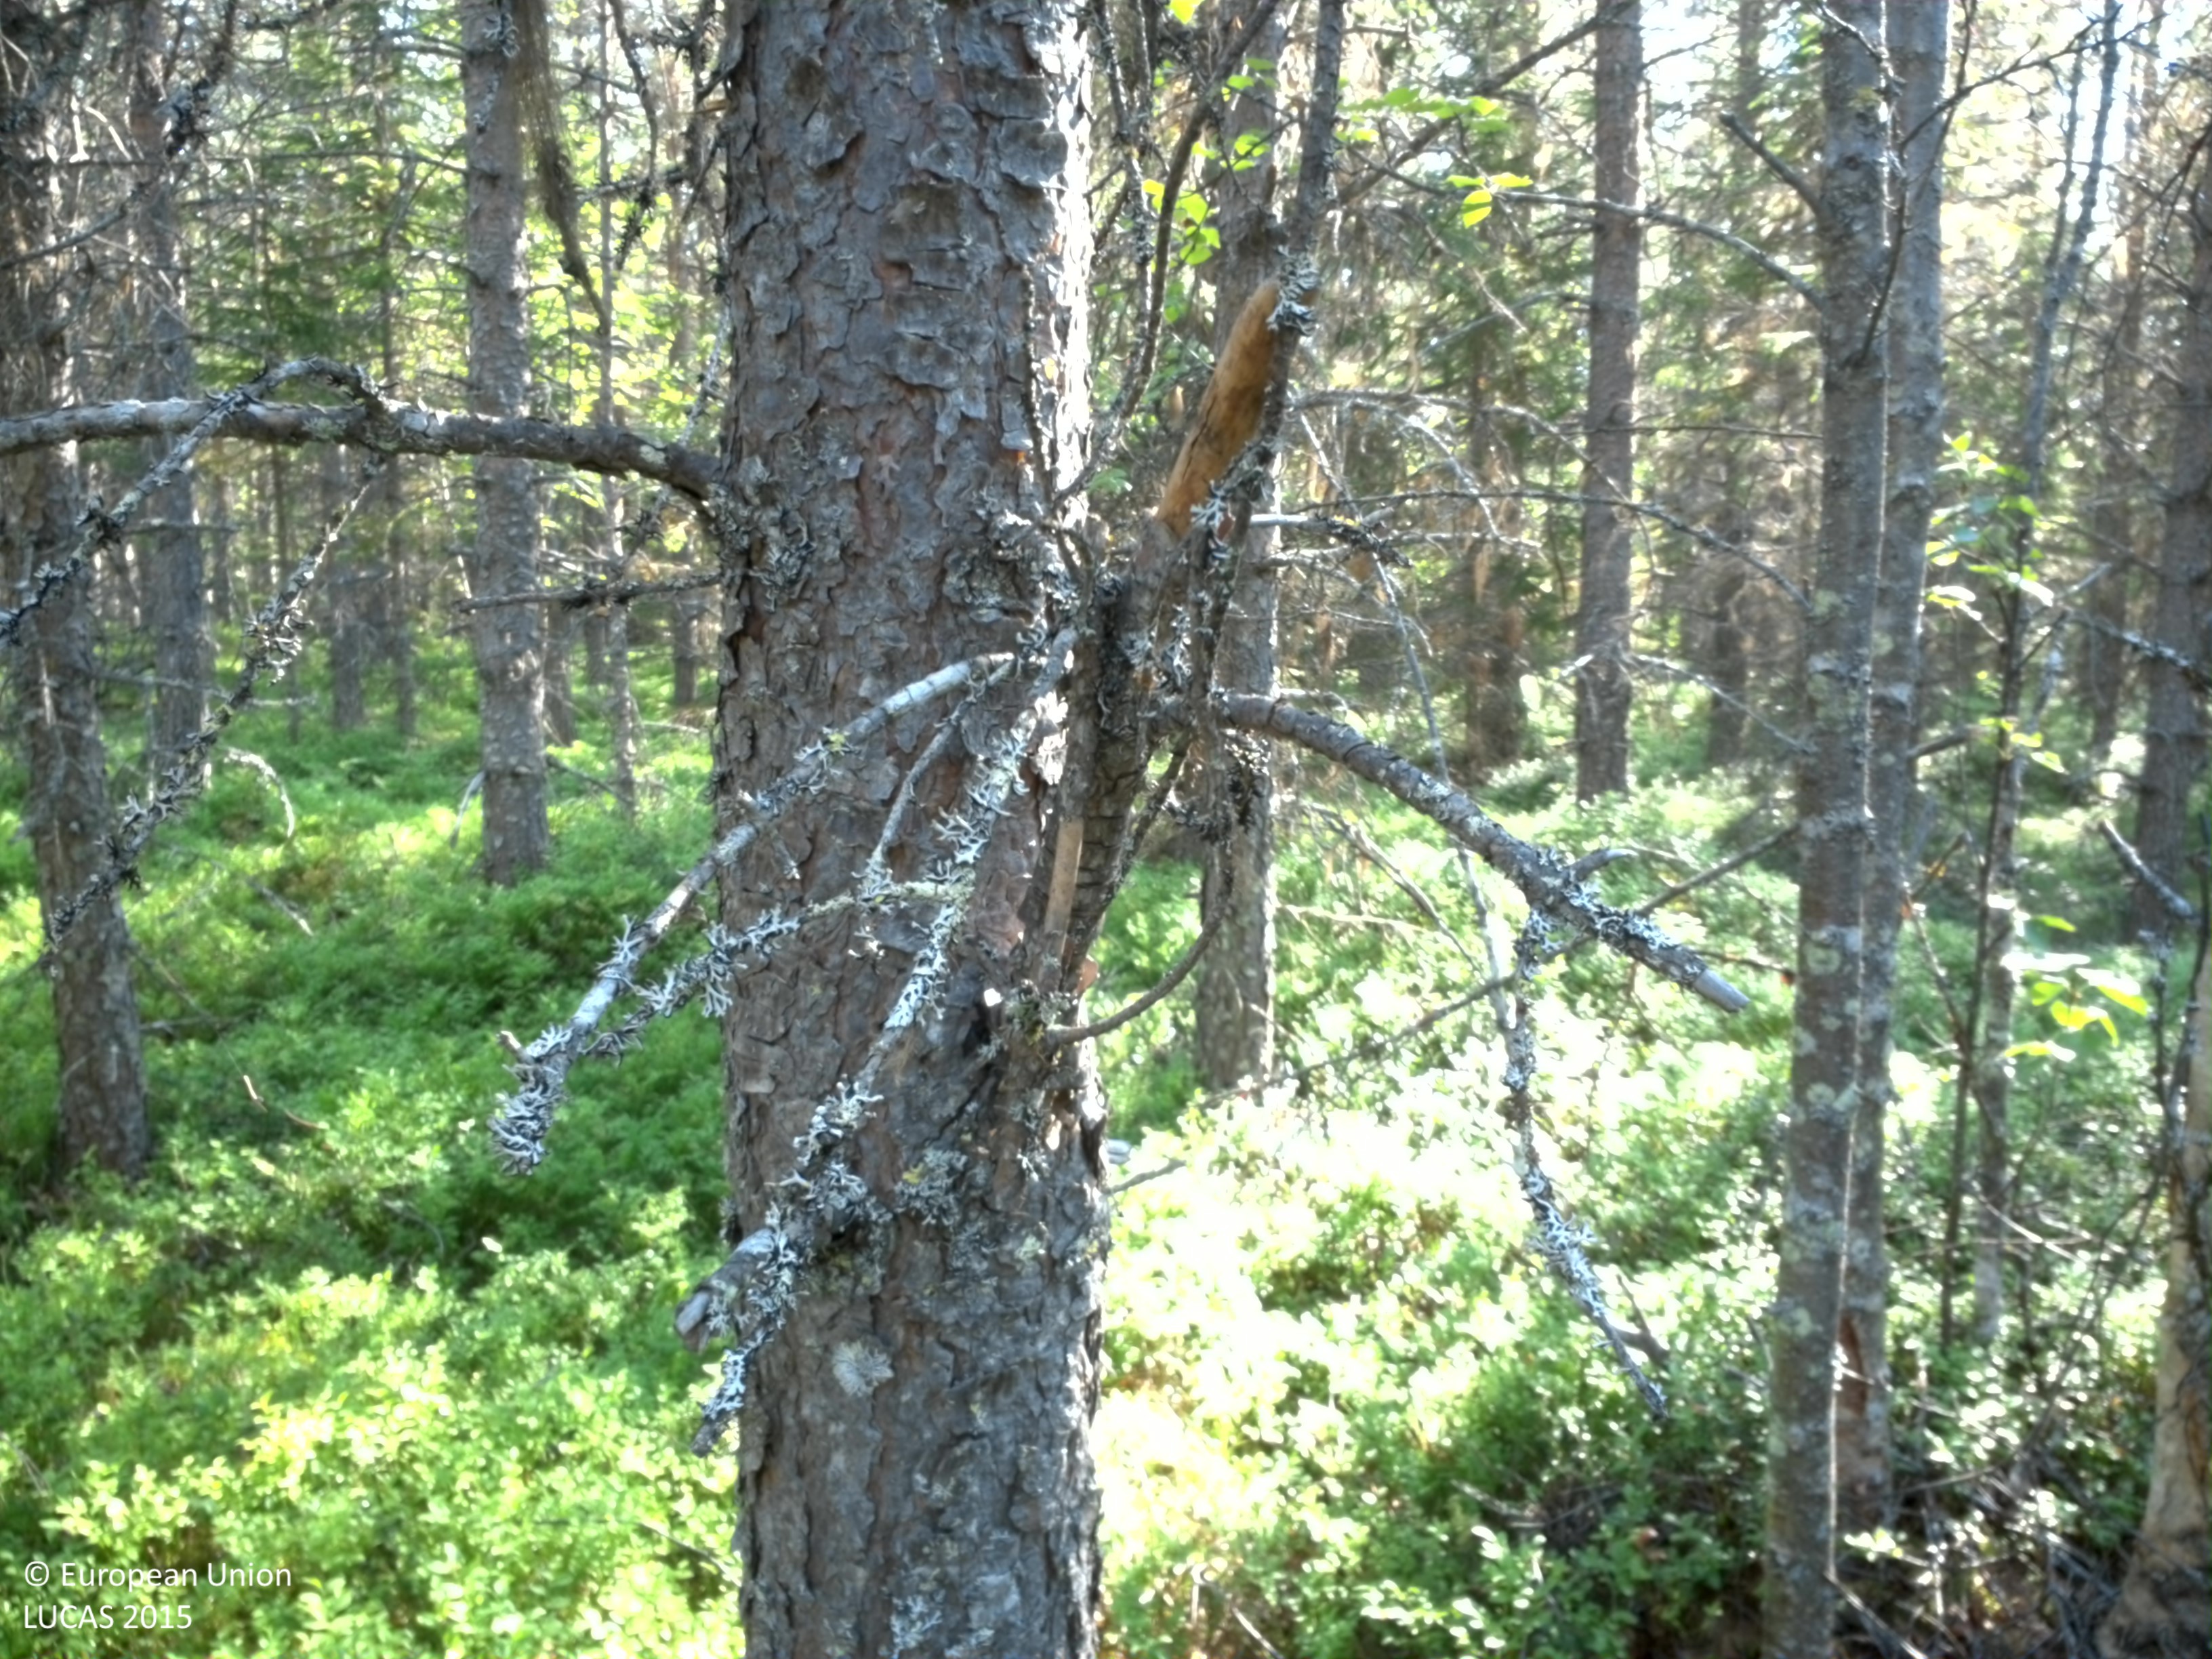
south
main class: Woodland
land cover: Pine dominated coniferous woodland
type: boreal forest
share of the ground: 25 - 50 %
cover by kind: coniferous forest trees 45 %, shrubs 35 %, herbaceous plants 10 %, lichens and mosses 10 %
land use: Forestry
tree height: > 5 m
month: August
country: SE
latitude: 64.6903
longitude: 16.7378
